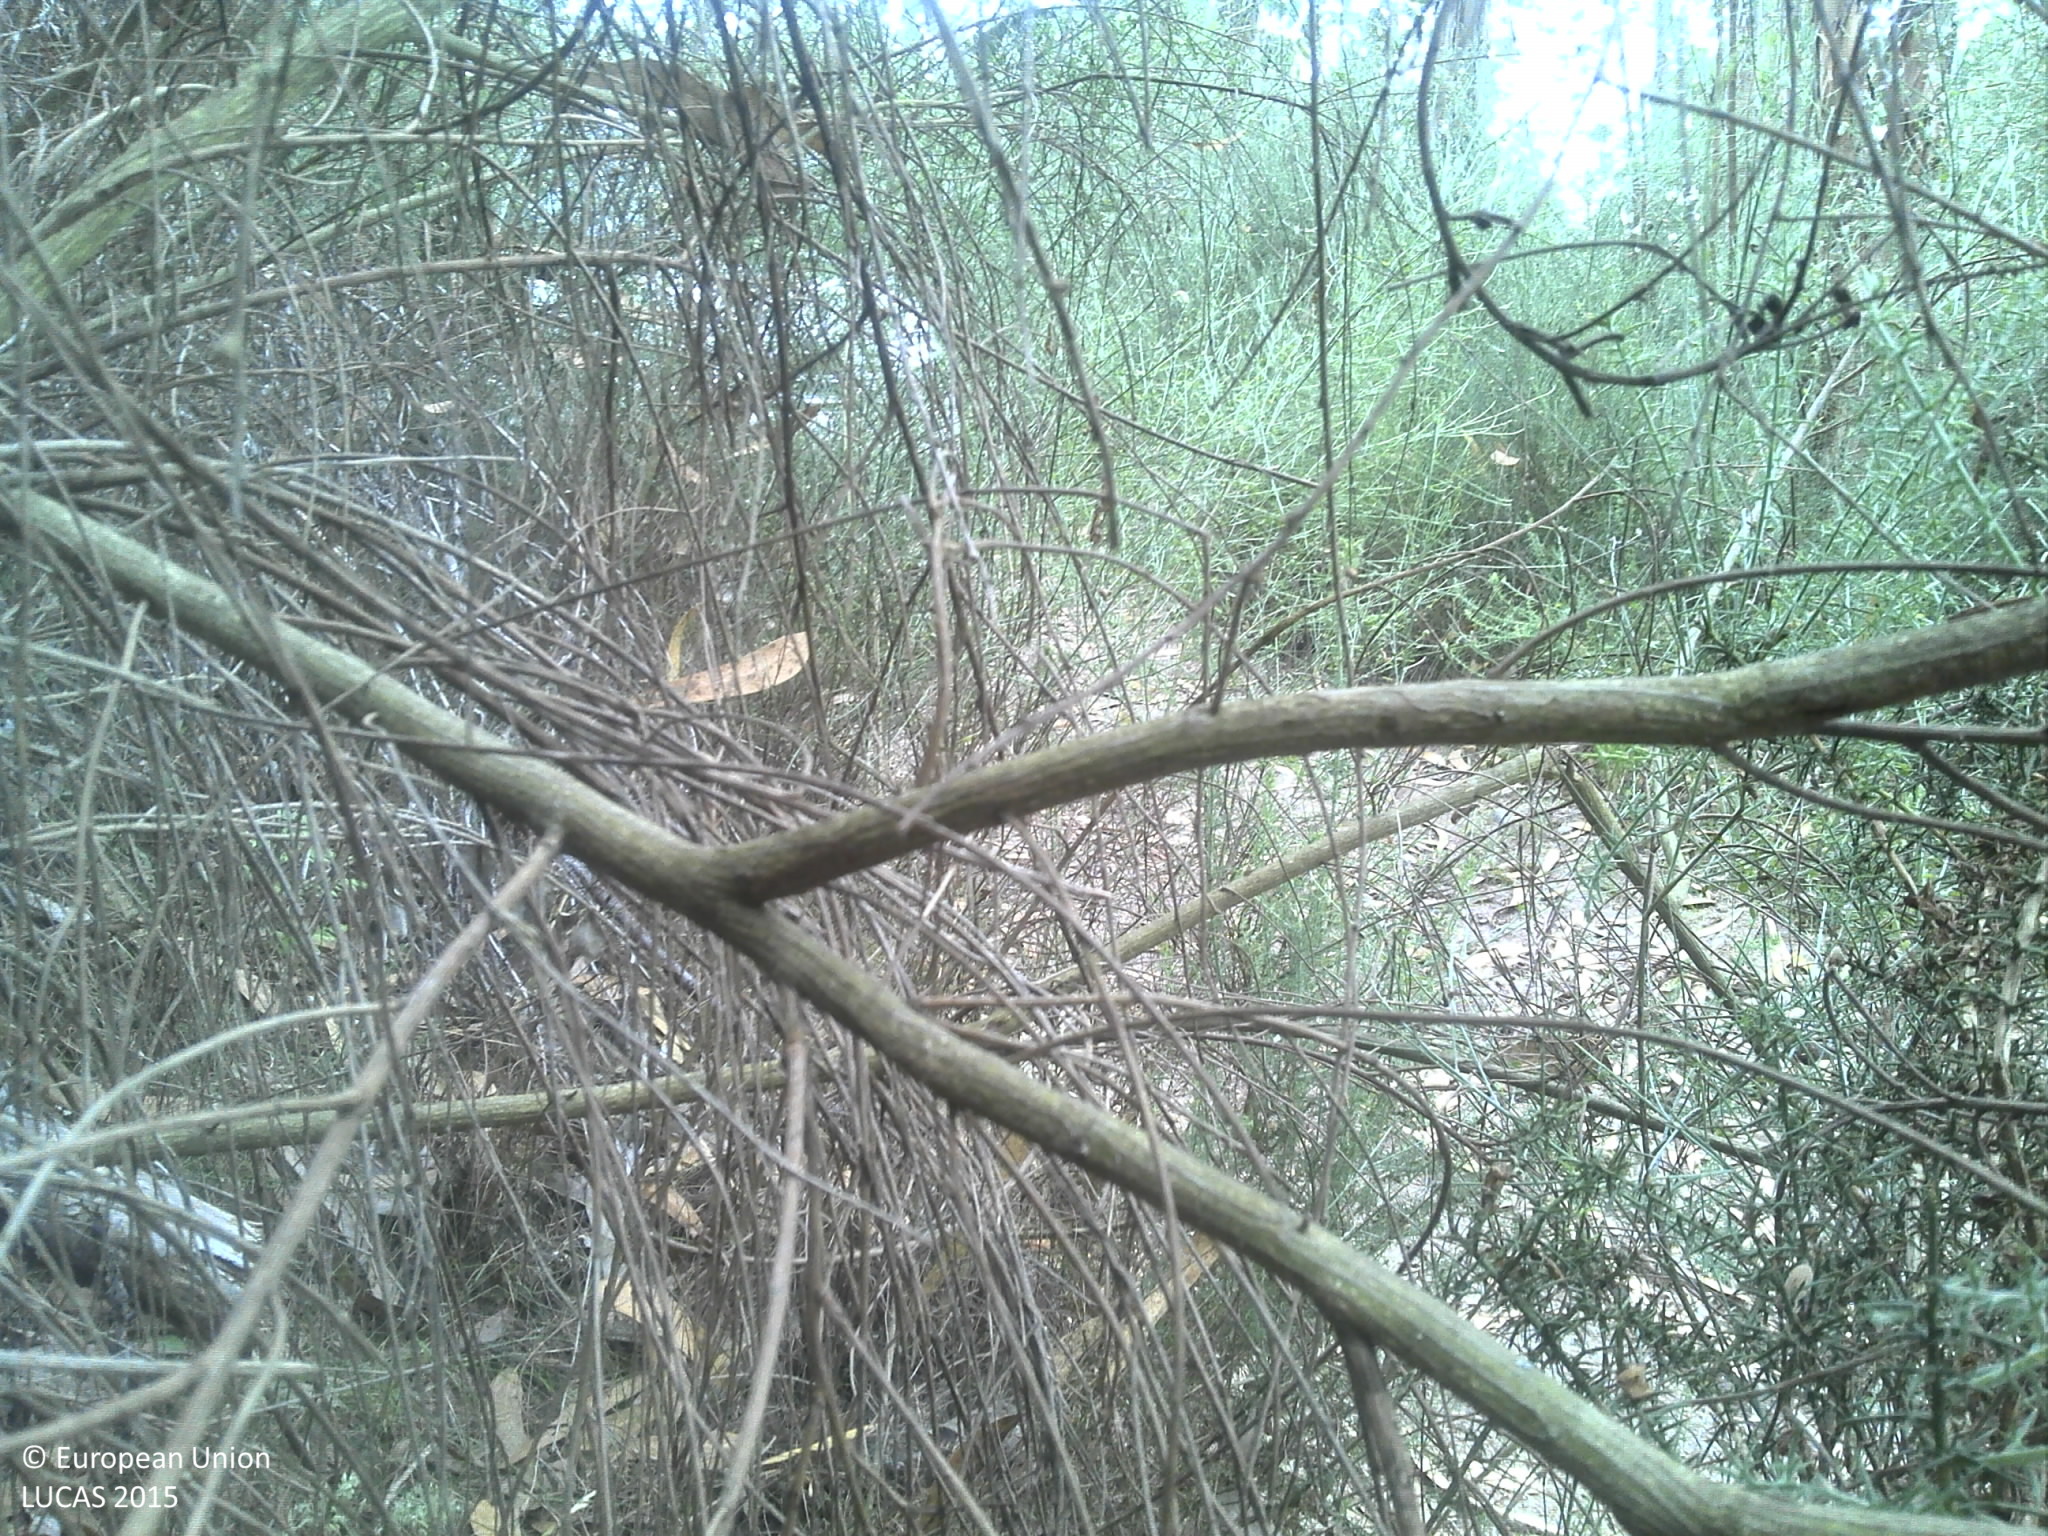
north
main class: Shrubland
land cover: Shrubland with sparse tree cover
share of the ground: > 75 %
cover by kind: shrubs 85 %, broadleaved forest trees 5 %, herbaceous plants 5 %, unconsolidated bare surface 5 %
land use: Forestry
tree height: > 5 m
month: June
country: PT
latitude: 41.3221
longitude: -8.2934
